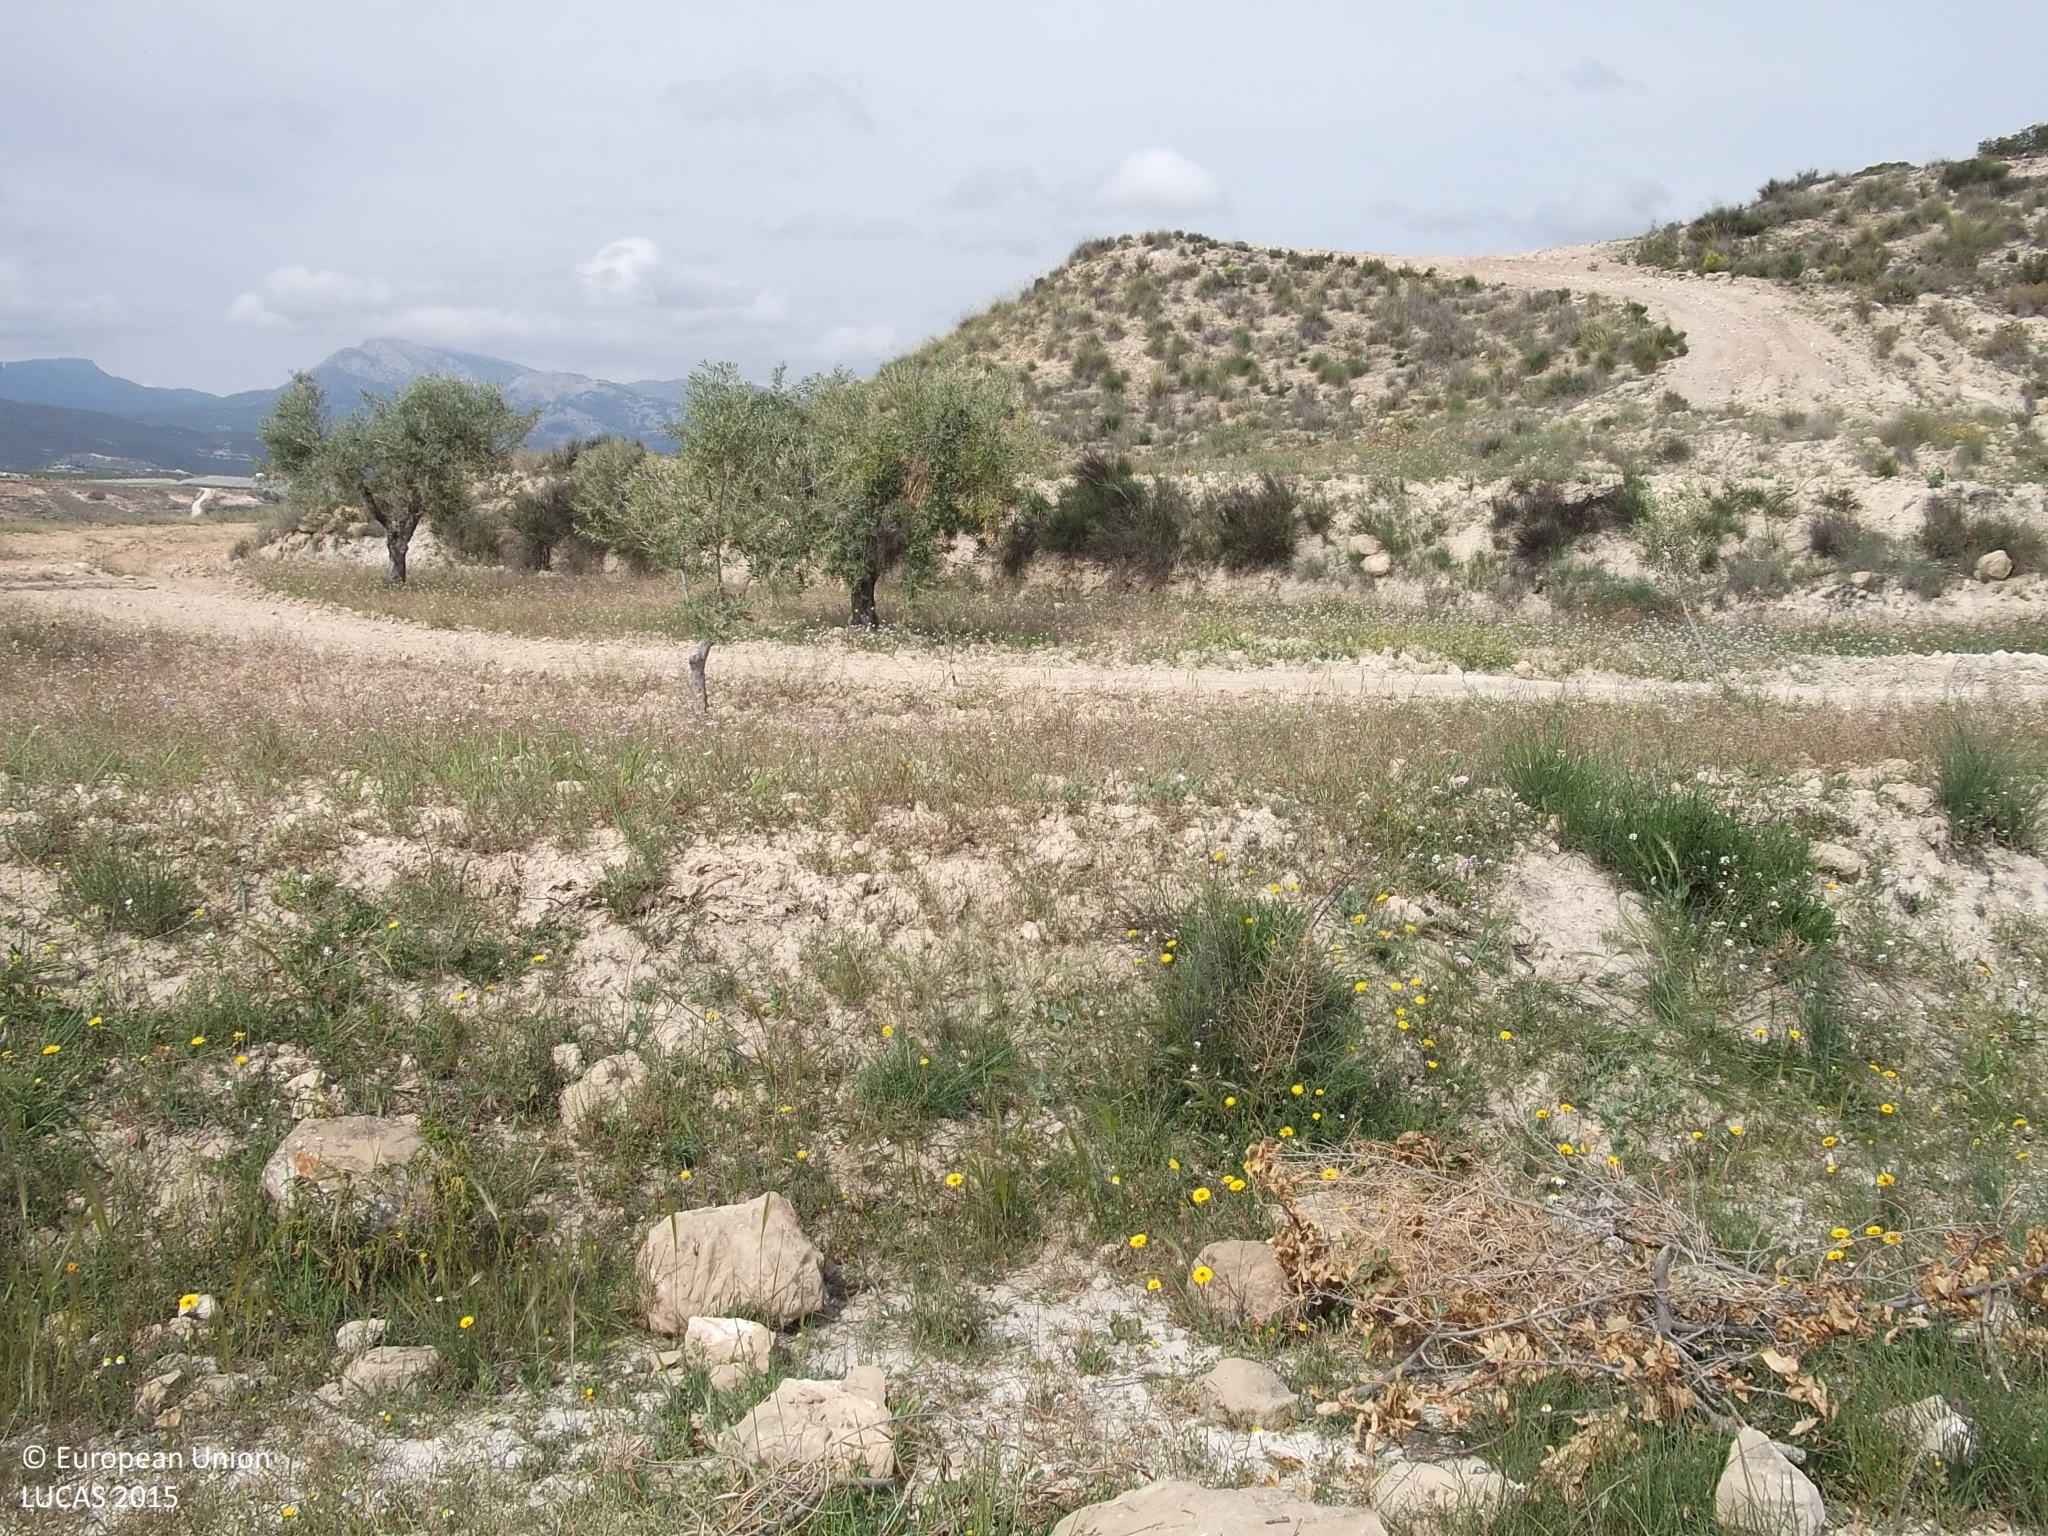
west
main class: Cropland
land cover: Nuts trees
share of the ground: 10 - 25 %
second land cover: Spontaneously vegetated surfaces
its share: > 75 %
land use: Agriculture (excluding fallow land and kitchen gardens)
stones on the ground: < 10 %
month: April
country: ES
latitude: 37.9202
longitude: -1.3940
